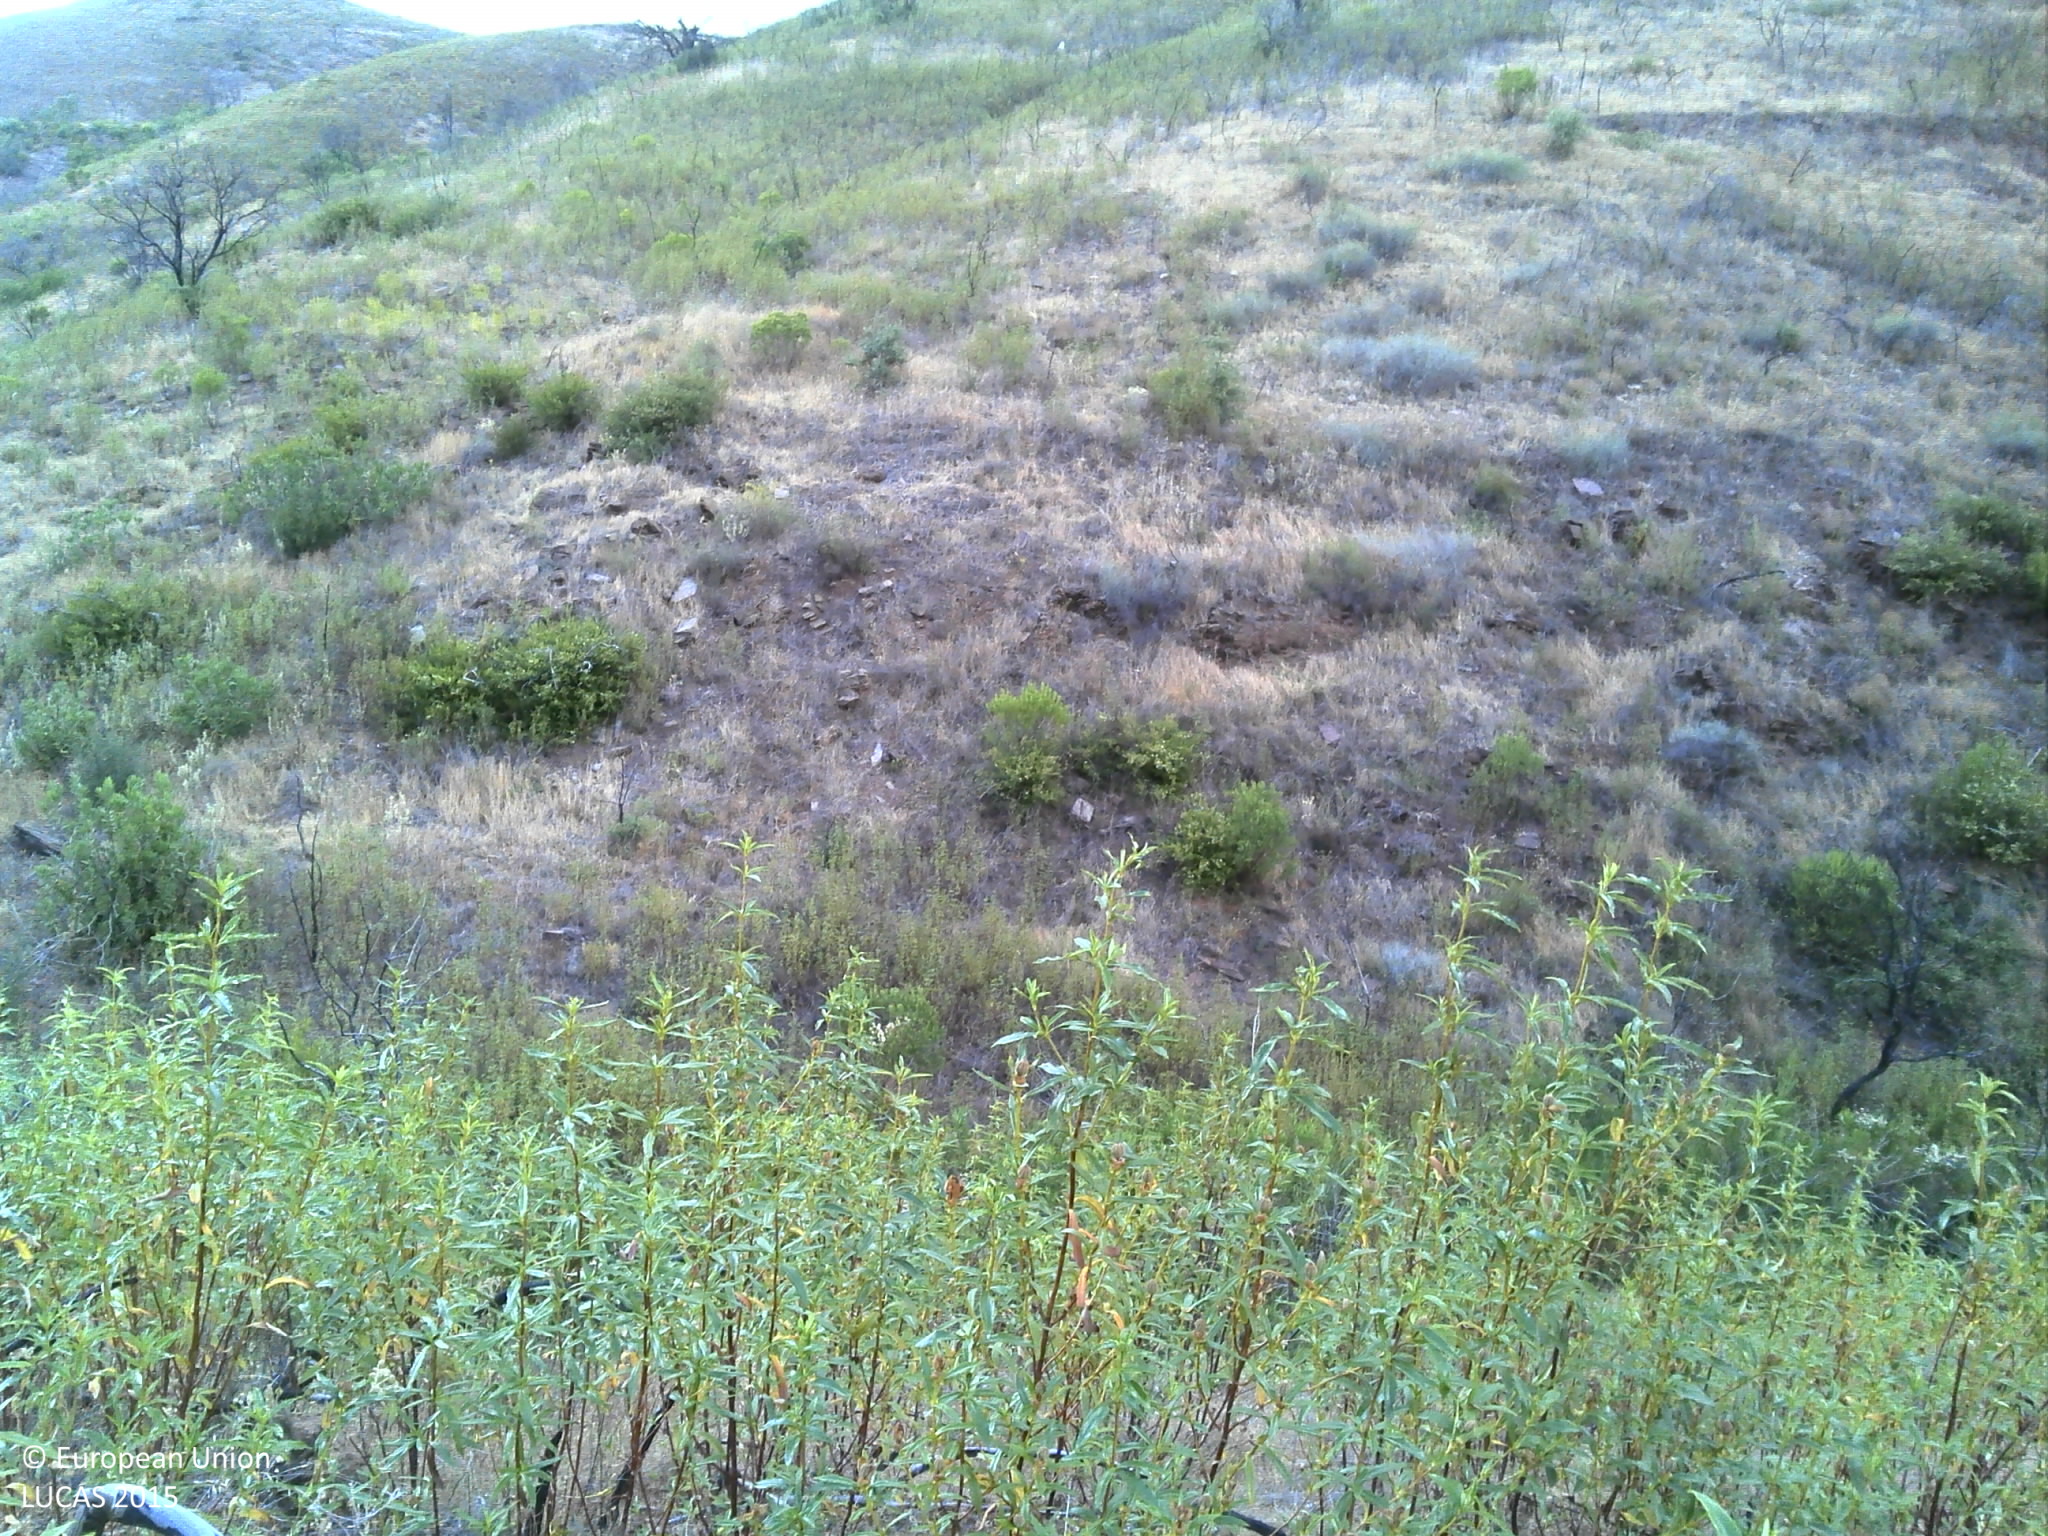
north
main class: Shrubland
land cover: Shrubland without tree cover
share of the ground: 50 - 75 %
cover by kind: shrubs 90 %, herbaceous plants 5 %, unconsolidated bare surface 5 %
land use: Abandoned areas
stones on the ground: < 10 %
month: June
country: PT
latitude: 37.2396
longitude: -7.6946
